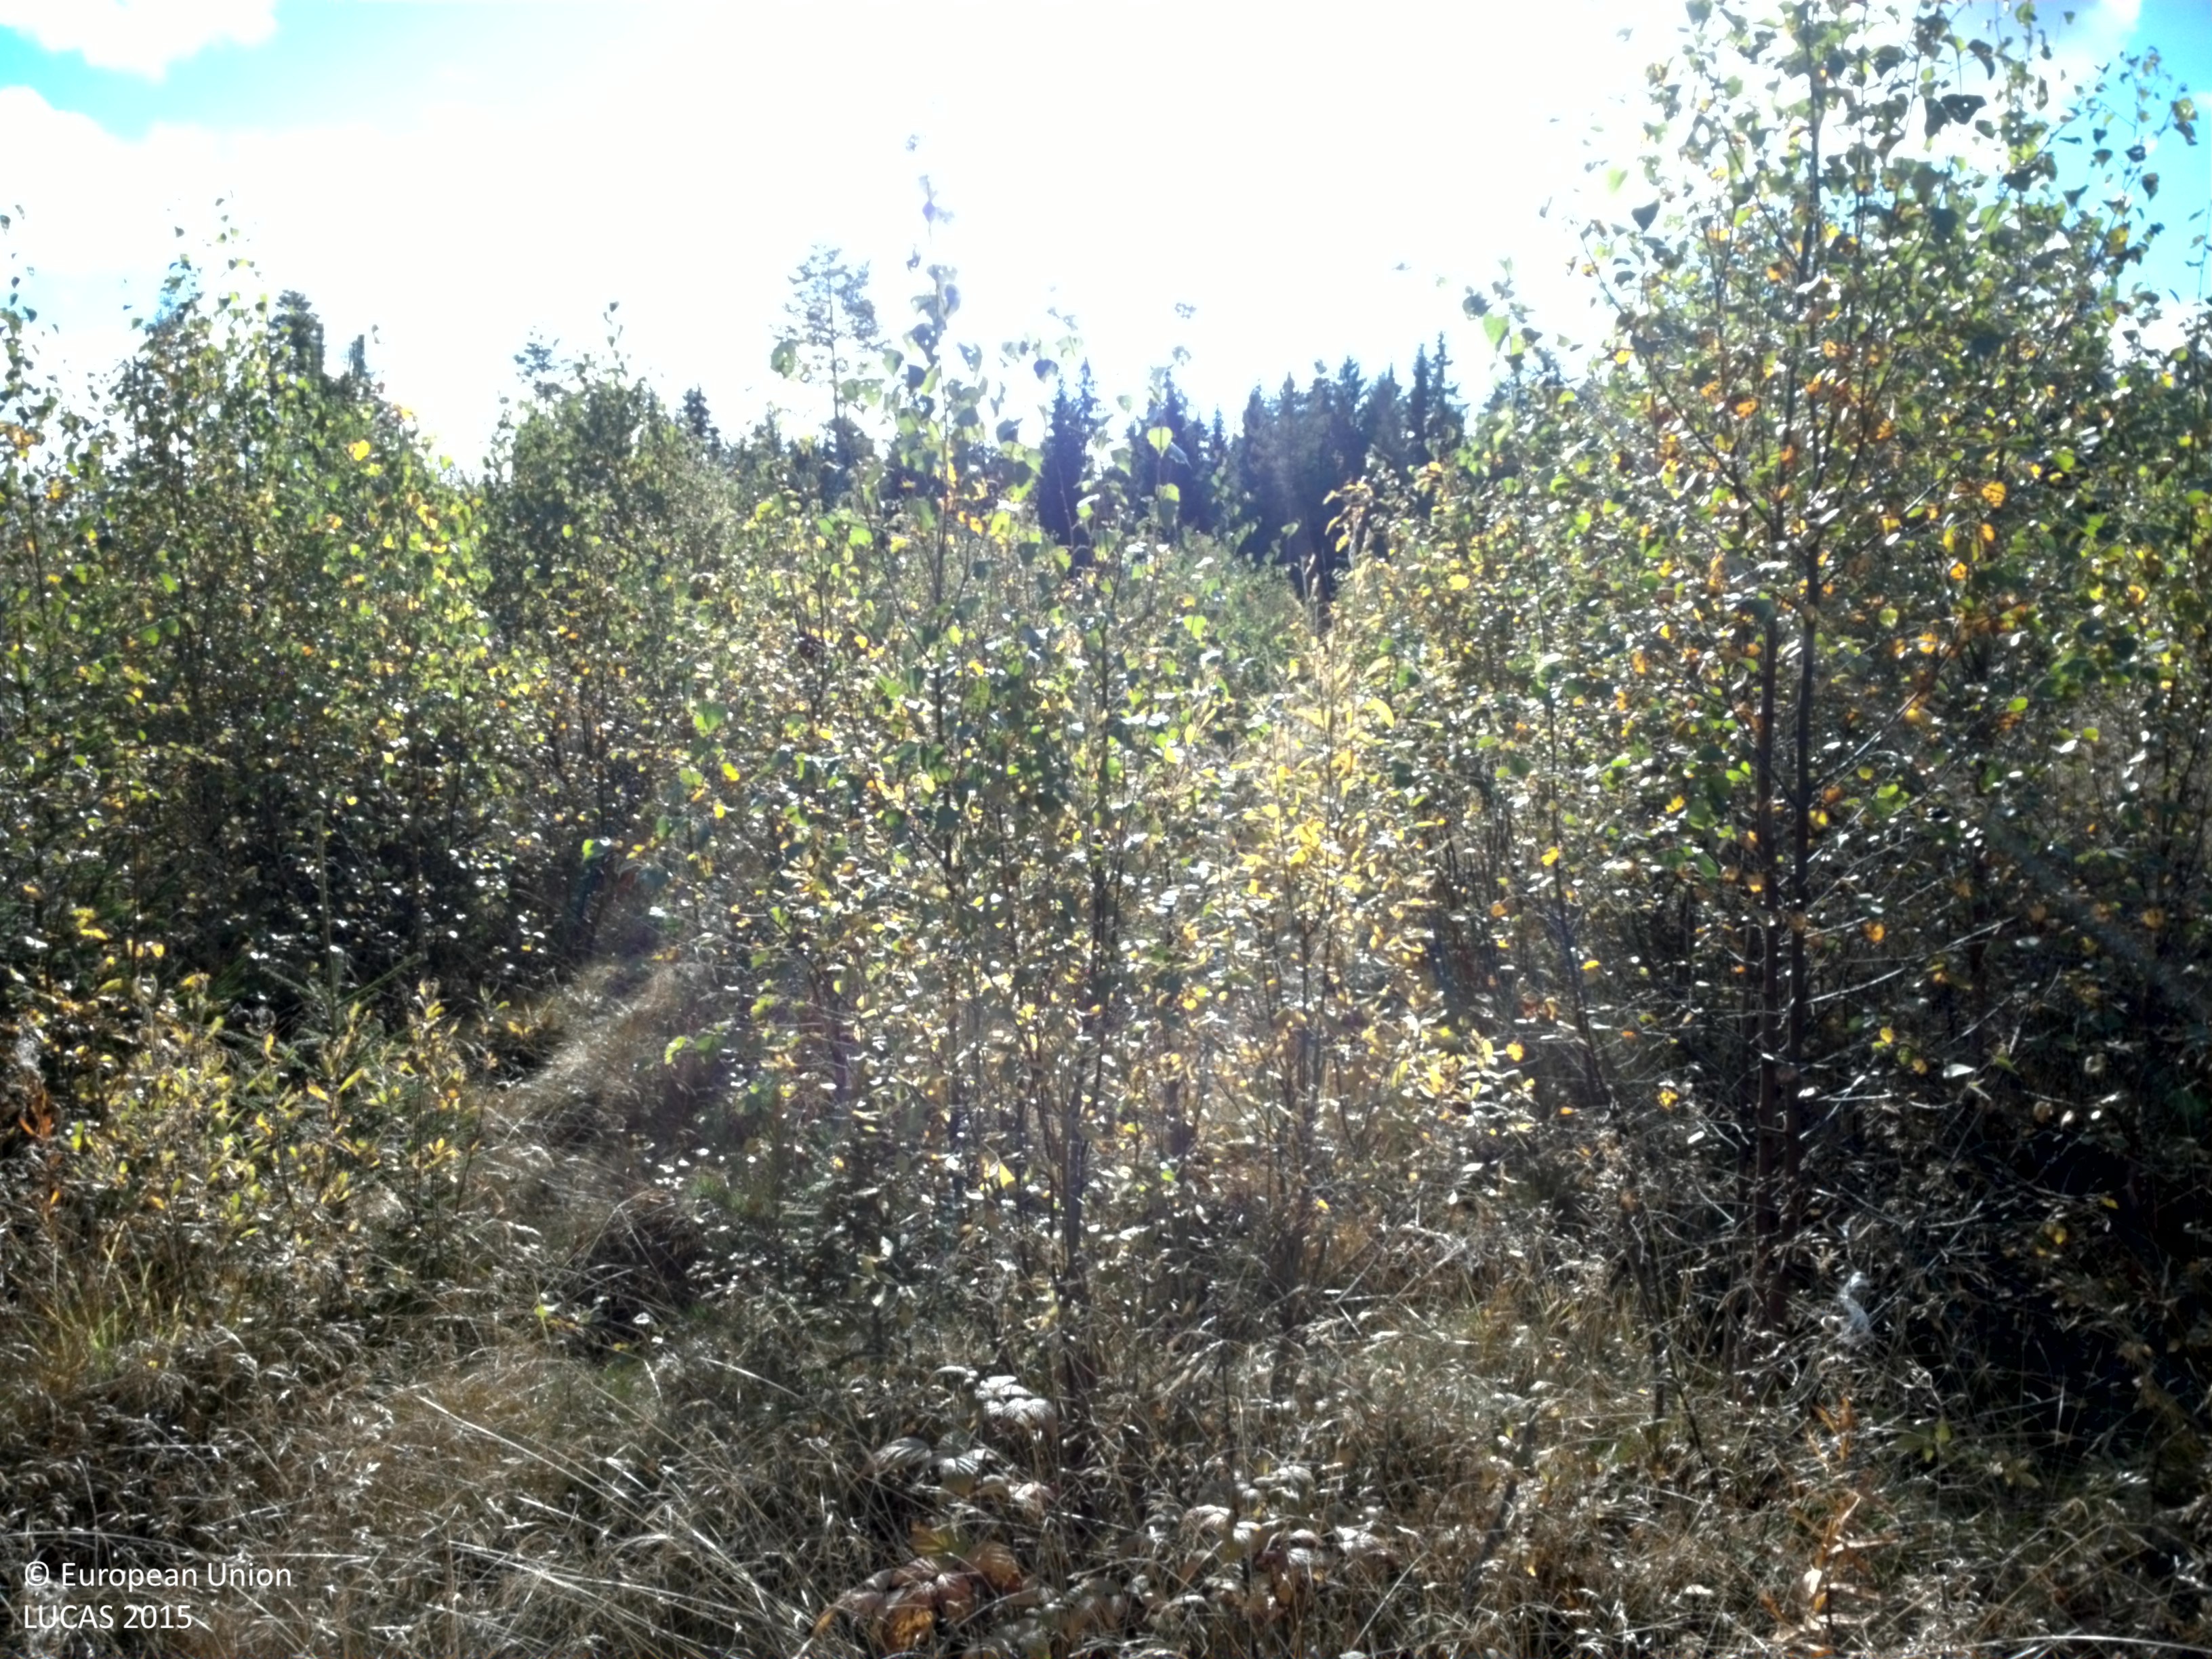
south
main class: Woodland
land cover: Spruce dominated mixed woodland
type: boreal forest
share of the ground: 25 - 50 %
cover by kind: coniferous forest trees 30 %, herbaceous plants 30 %, lichens and mosses 30 %, broadleaved forest trees 10 %
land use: Forestry
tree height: > 5 m
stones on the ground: 10 - 25 %
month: September
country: SE
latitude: 60.0876
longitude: 16.4441
